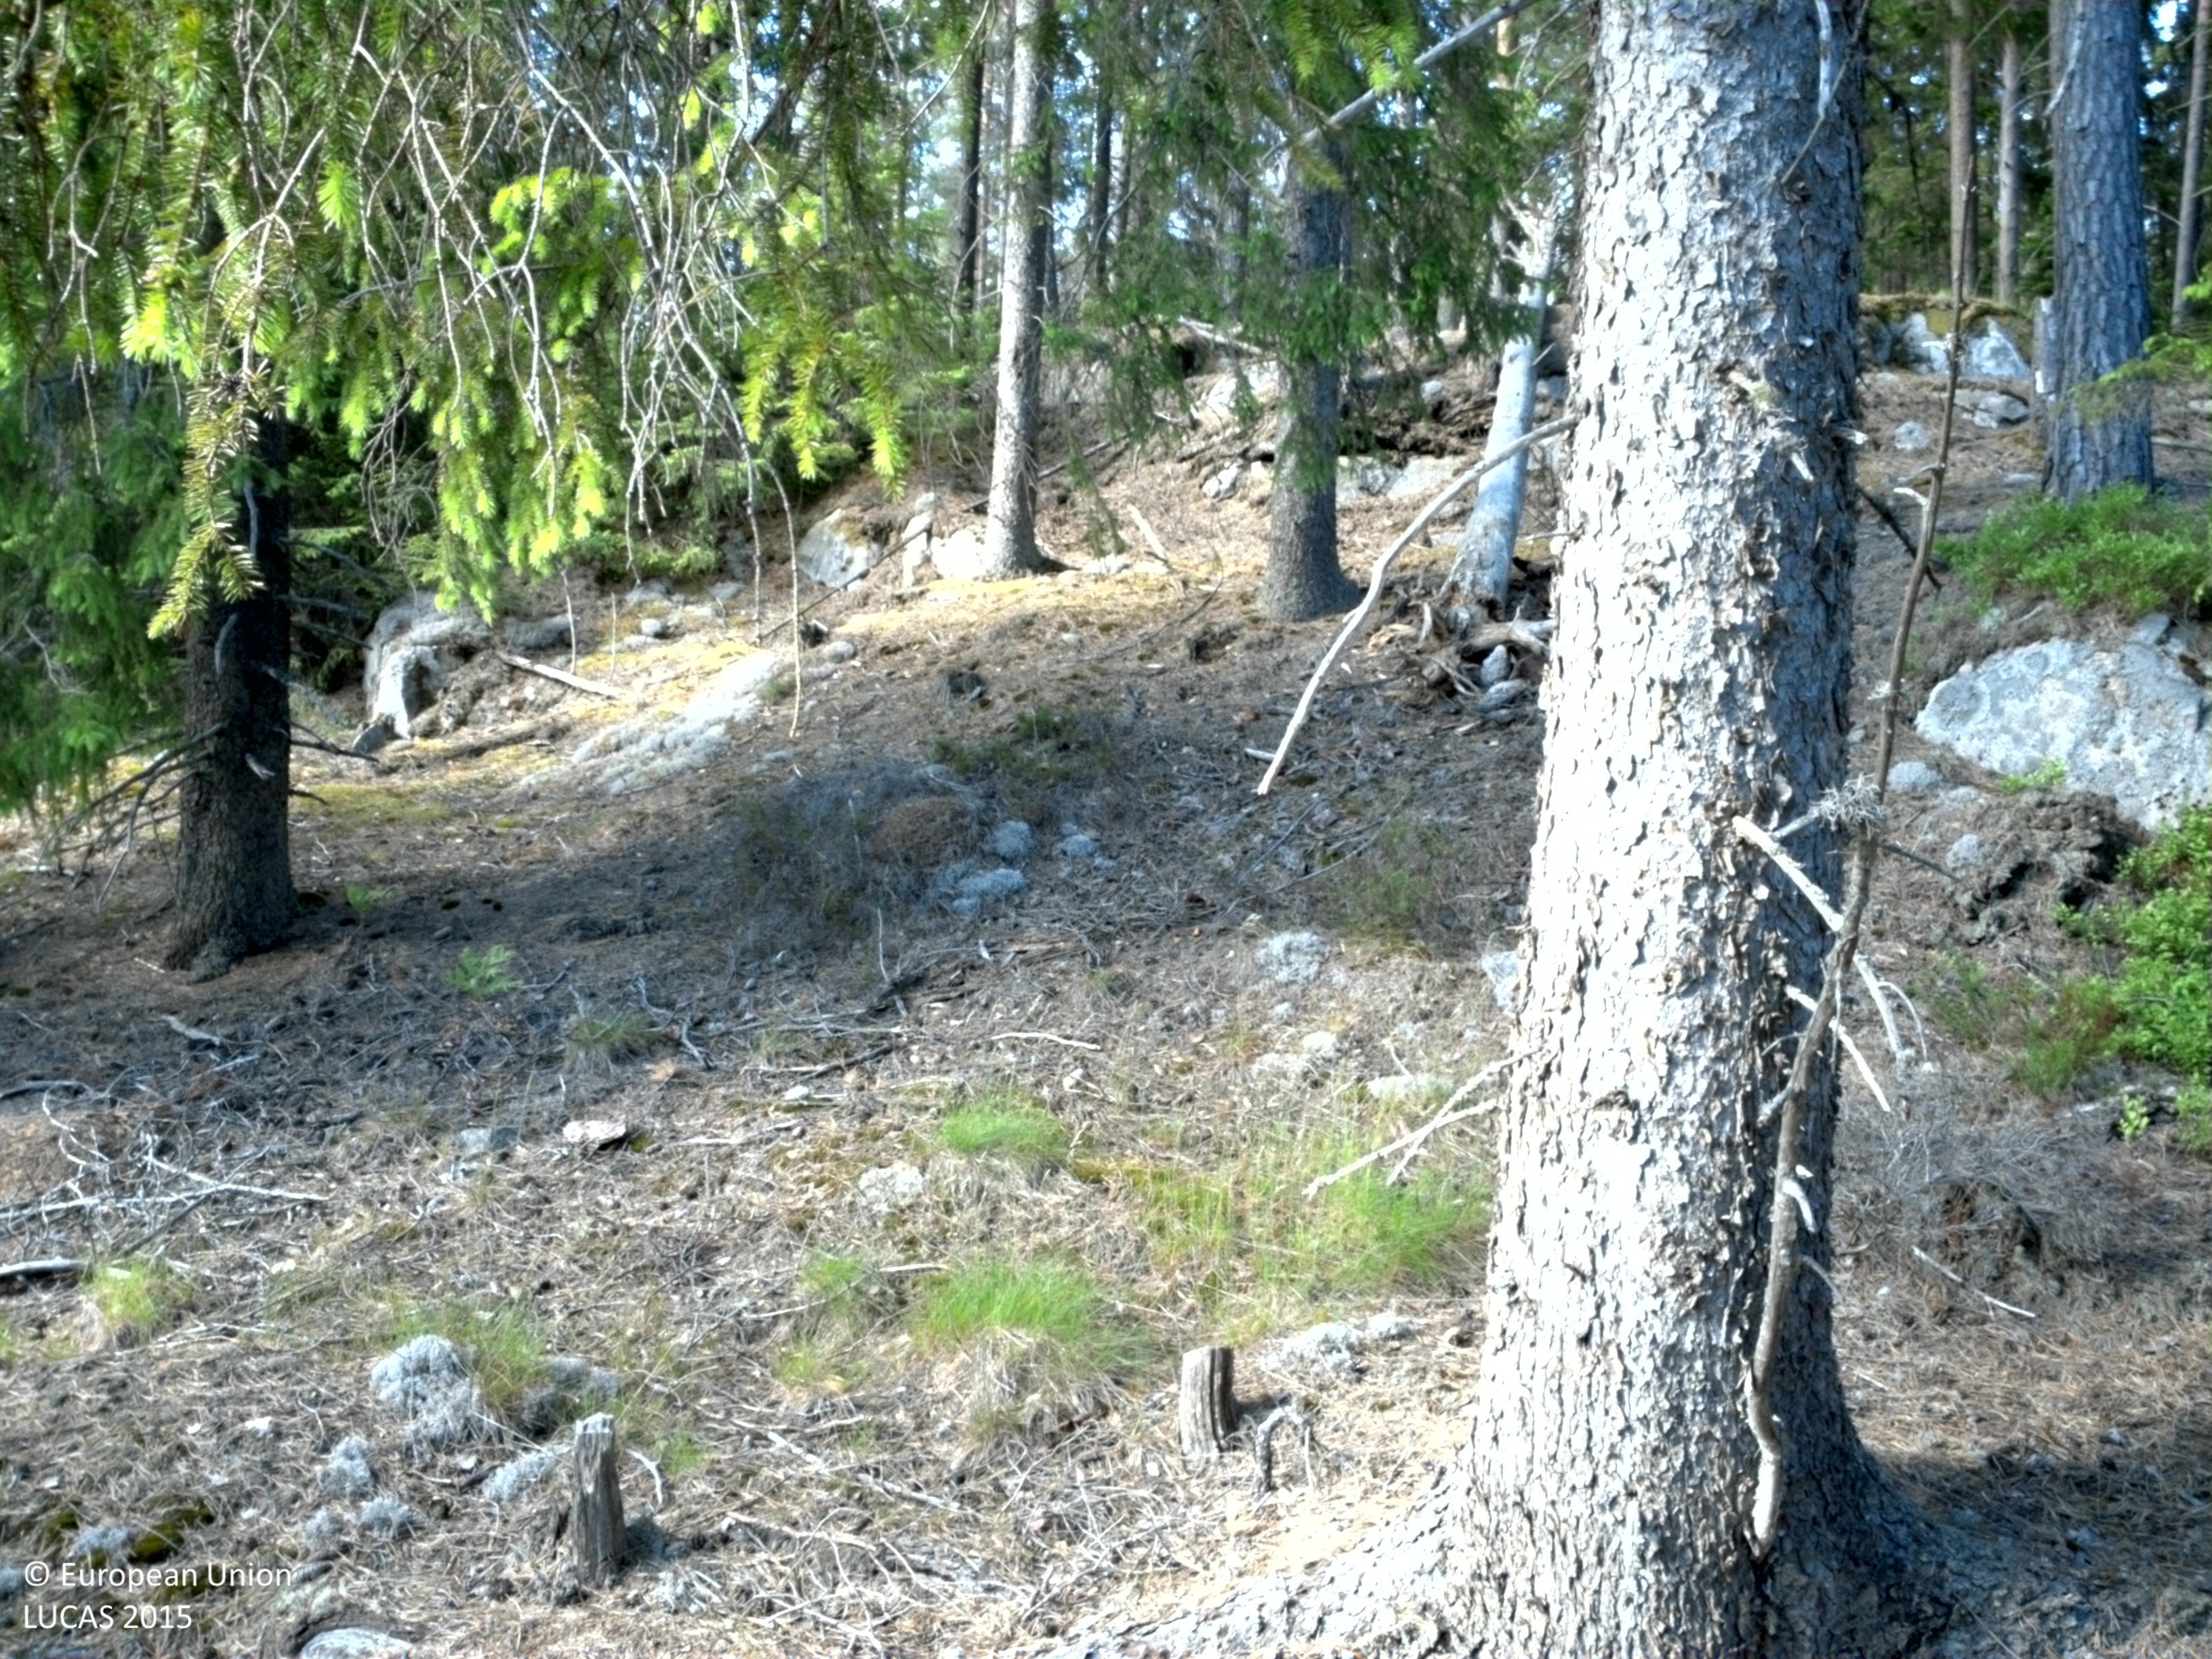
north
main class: Woodland
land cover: Other coniferous woodland
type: boreal forest
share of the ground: > 75 %
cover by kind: coniferous forest trees 80 %, broadleaved forest trees 5 %, shrubs 5 %, herbaceous plants 5 %, lichens and mosses 5 %
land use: Forestry
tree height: > 5 m
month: June
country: SE
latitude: 58.7330
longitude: 14.6742
